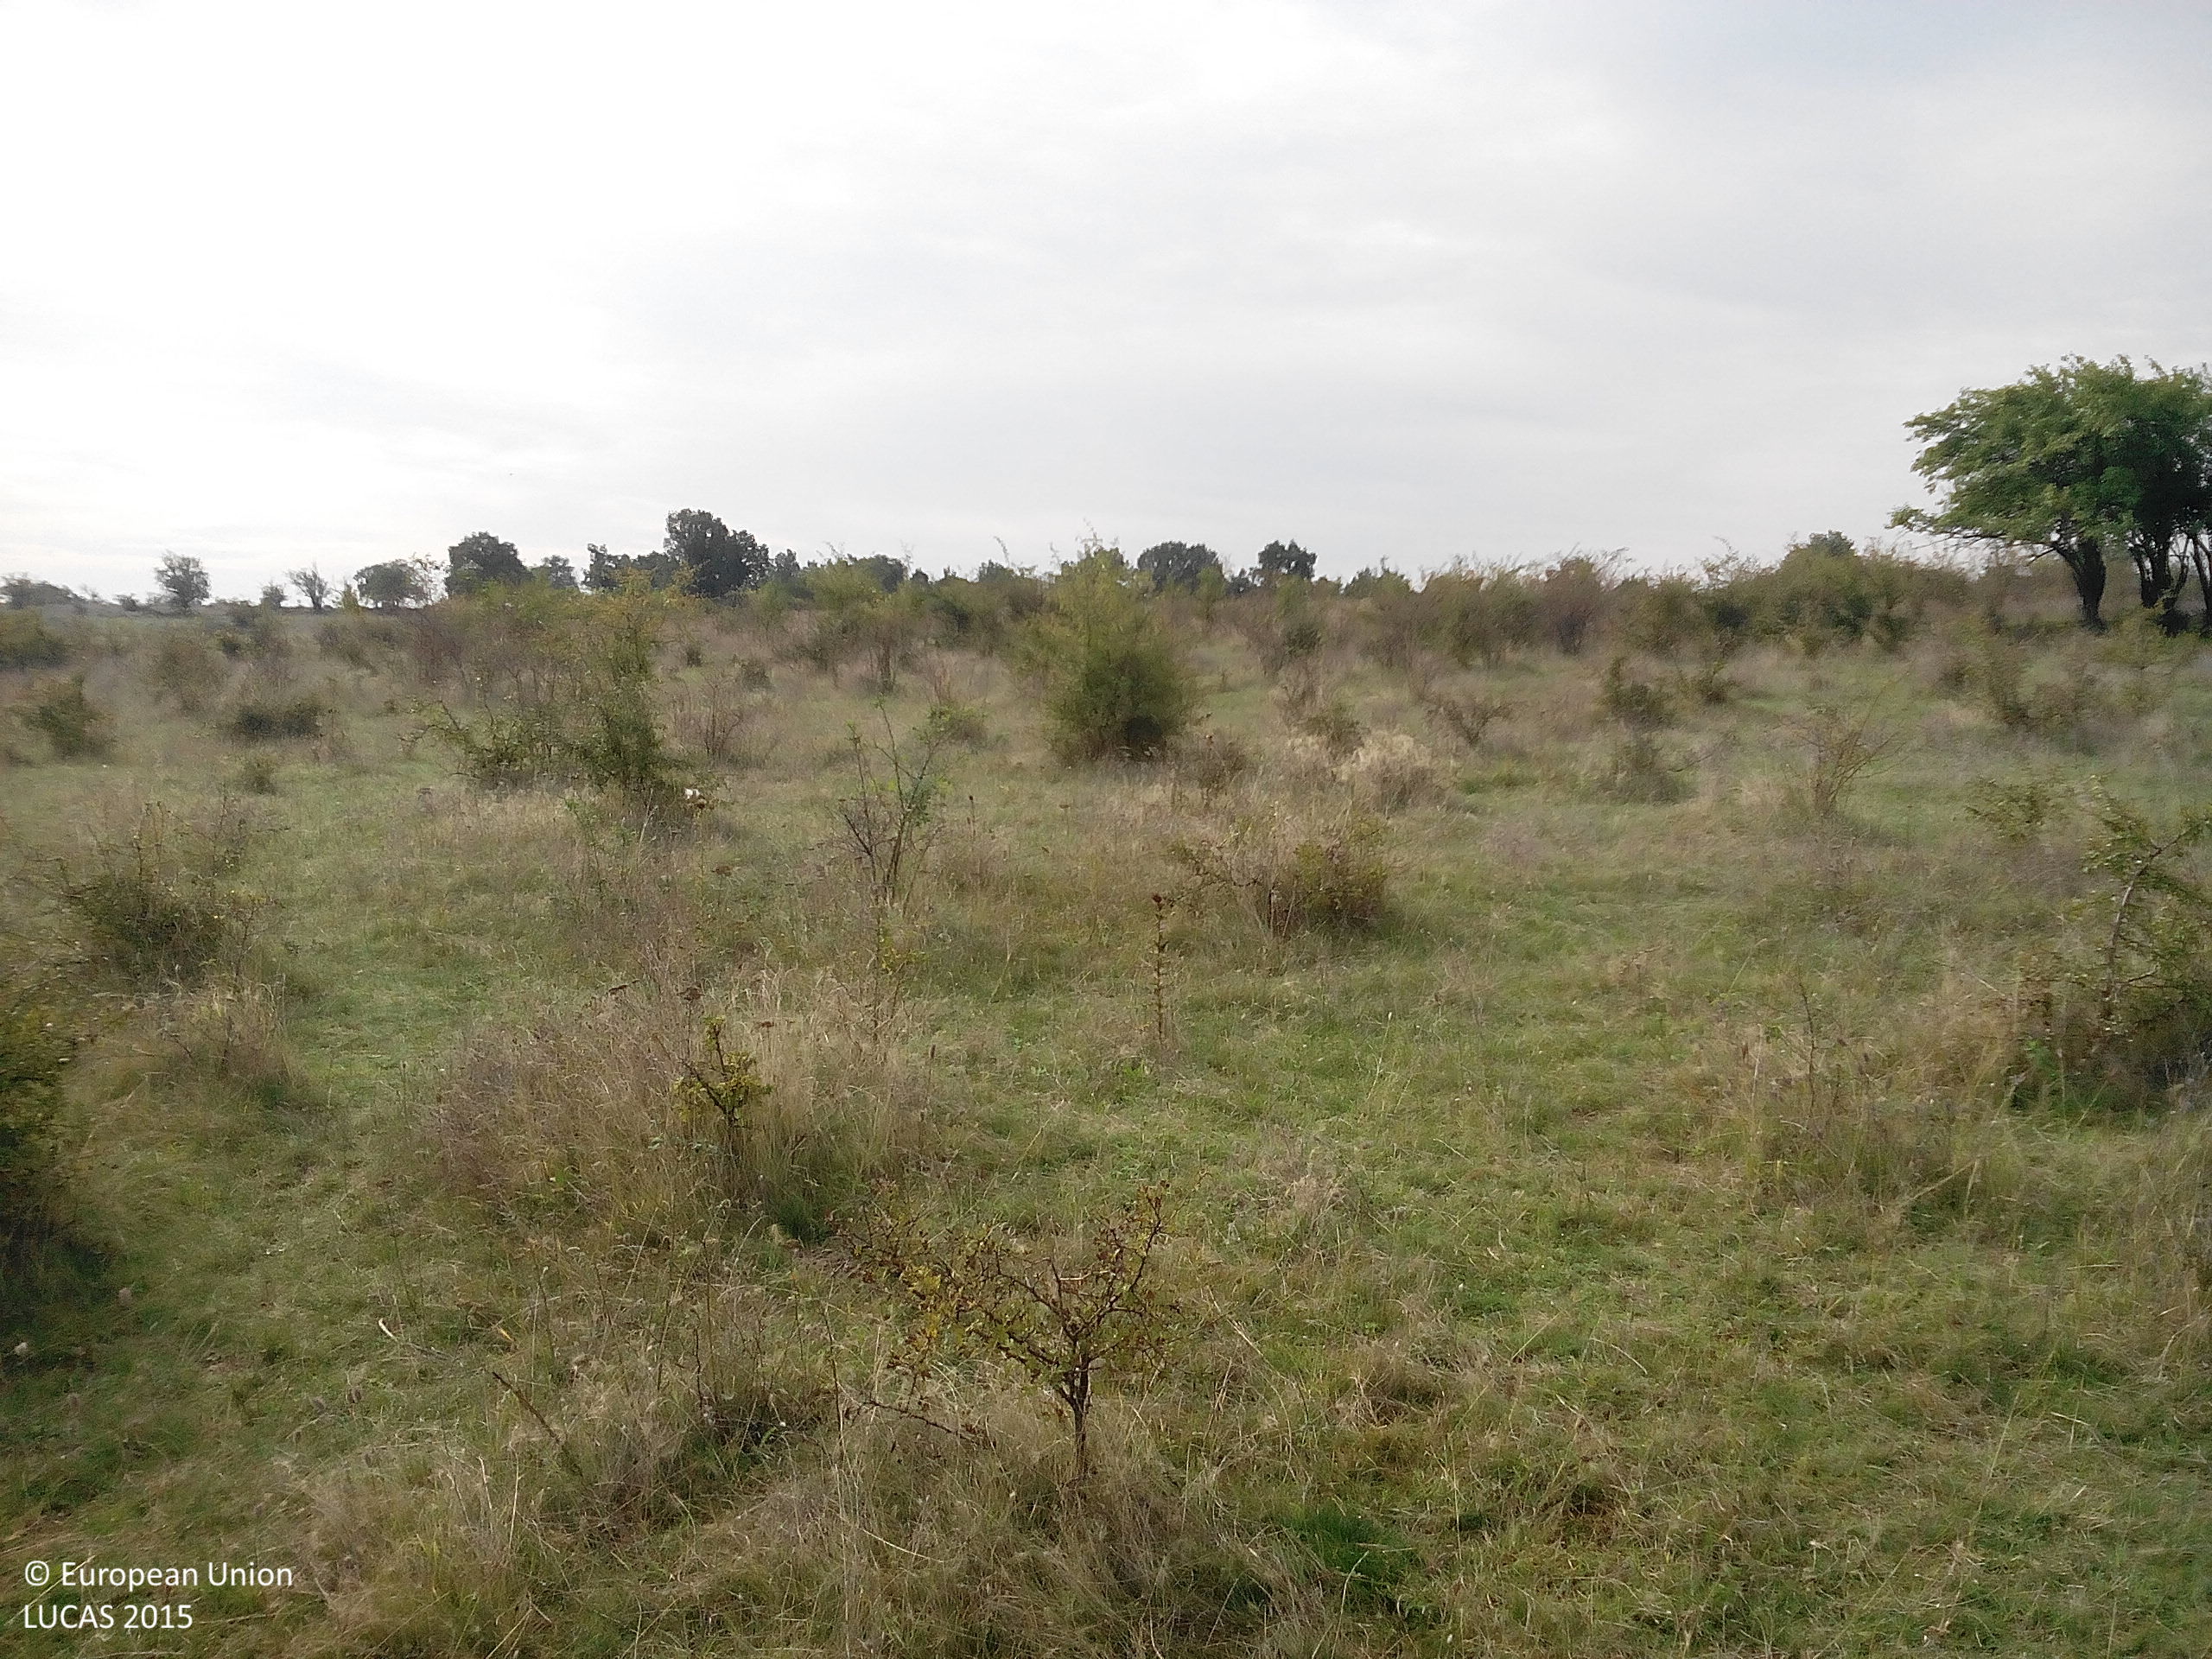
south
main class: Shrubland
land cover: Shrubland without tree cover
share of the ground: > 75 %
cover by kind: herbaceous plants 80 %, shrubs 20 %
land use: Abandoned areas
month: October
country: BG
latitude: 43.2237
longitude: 23.9238
